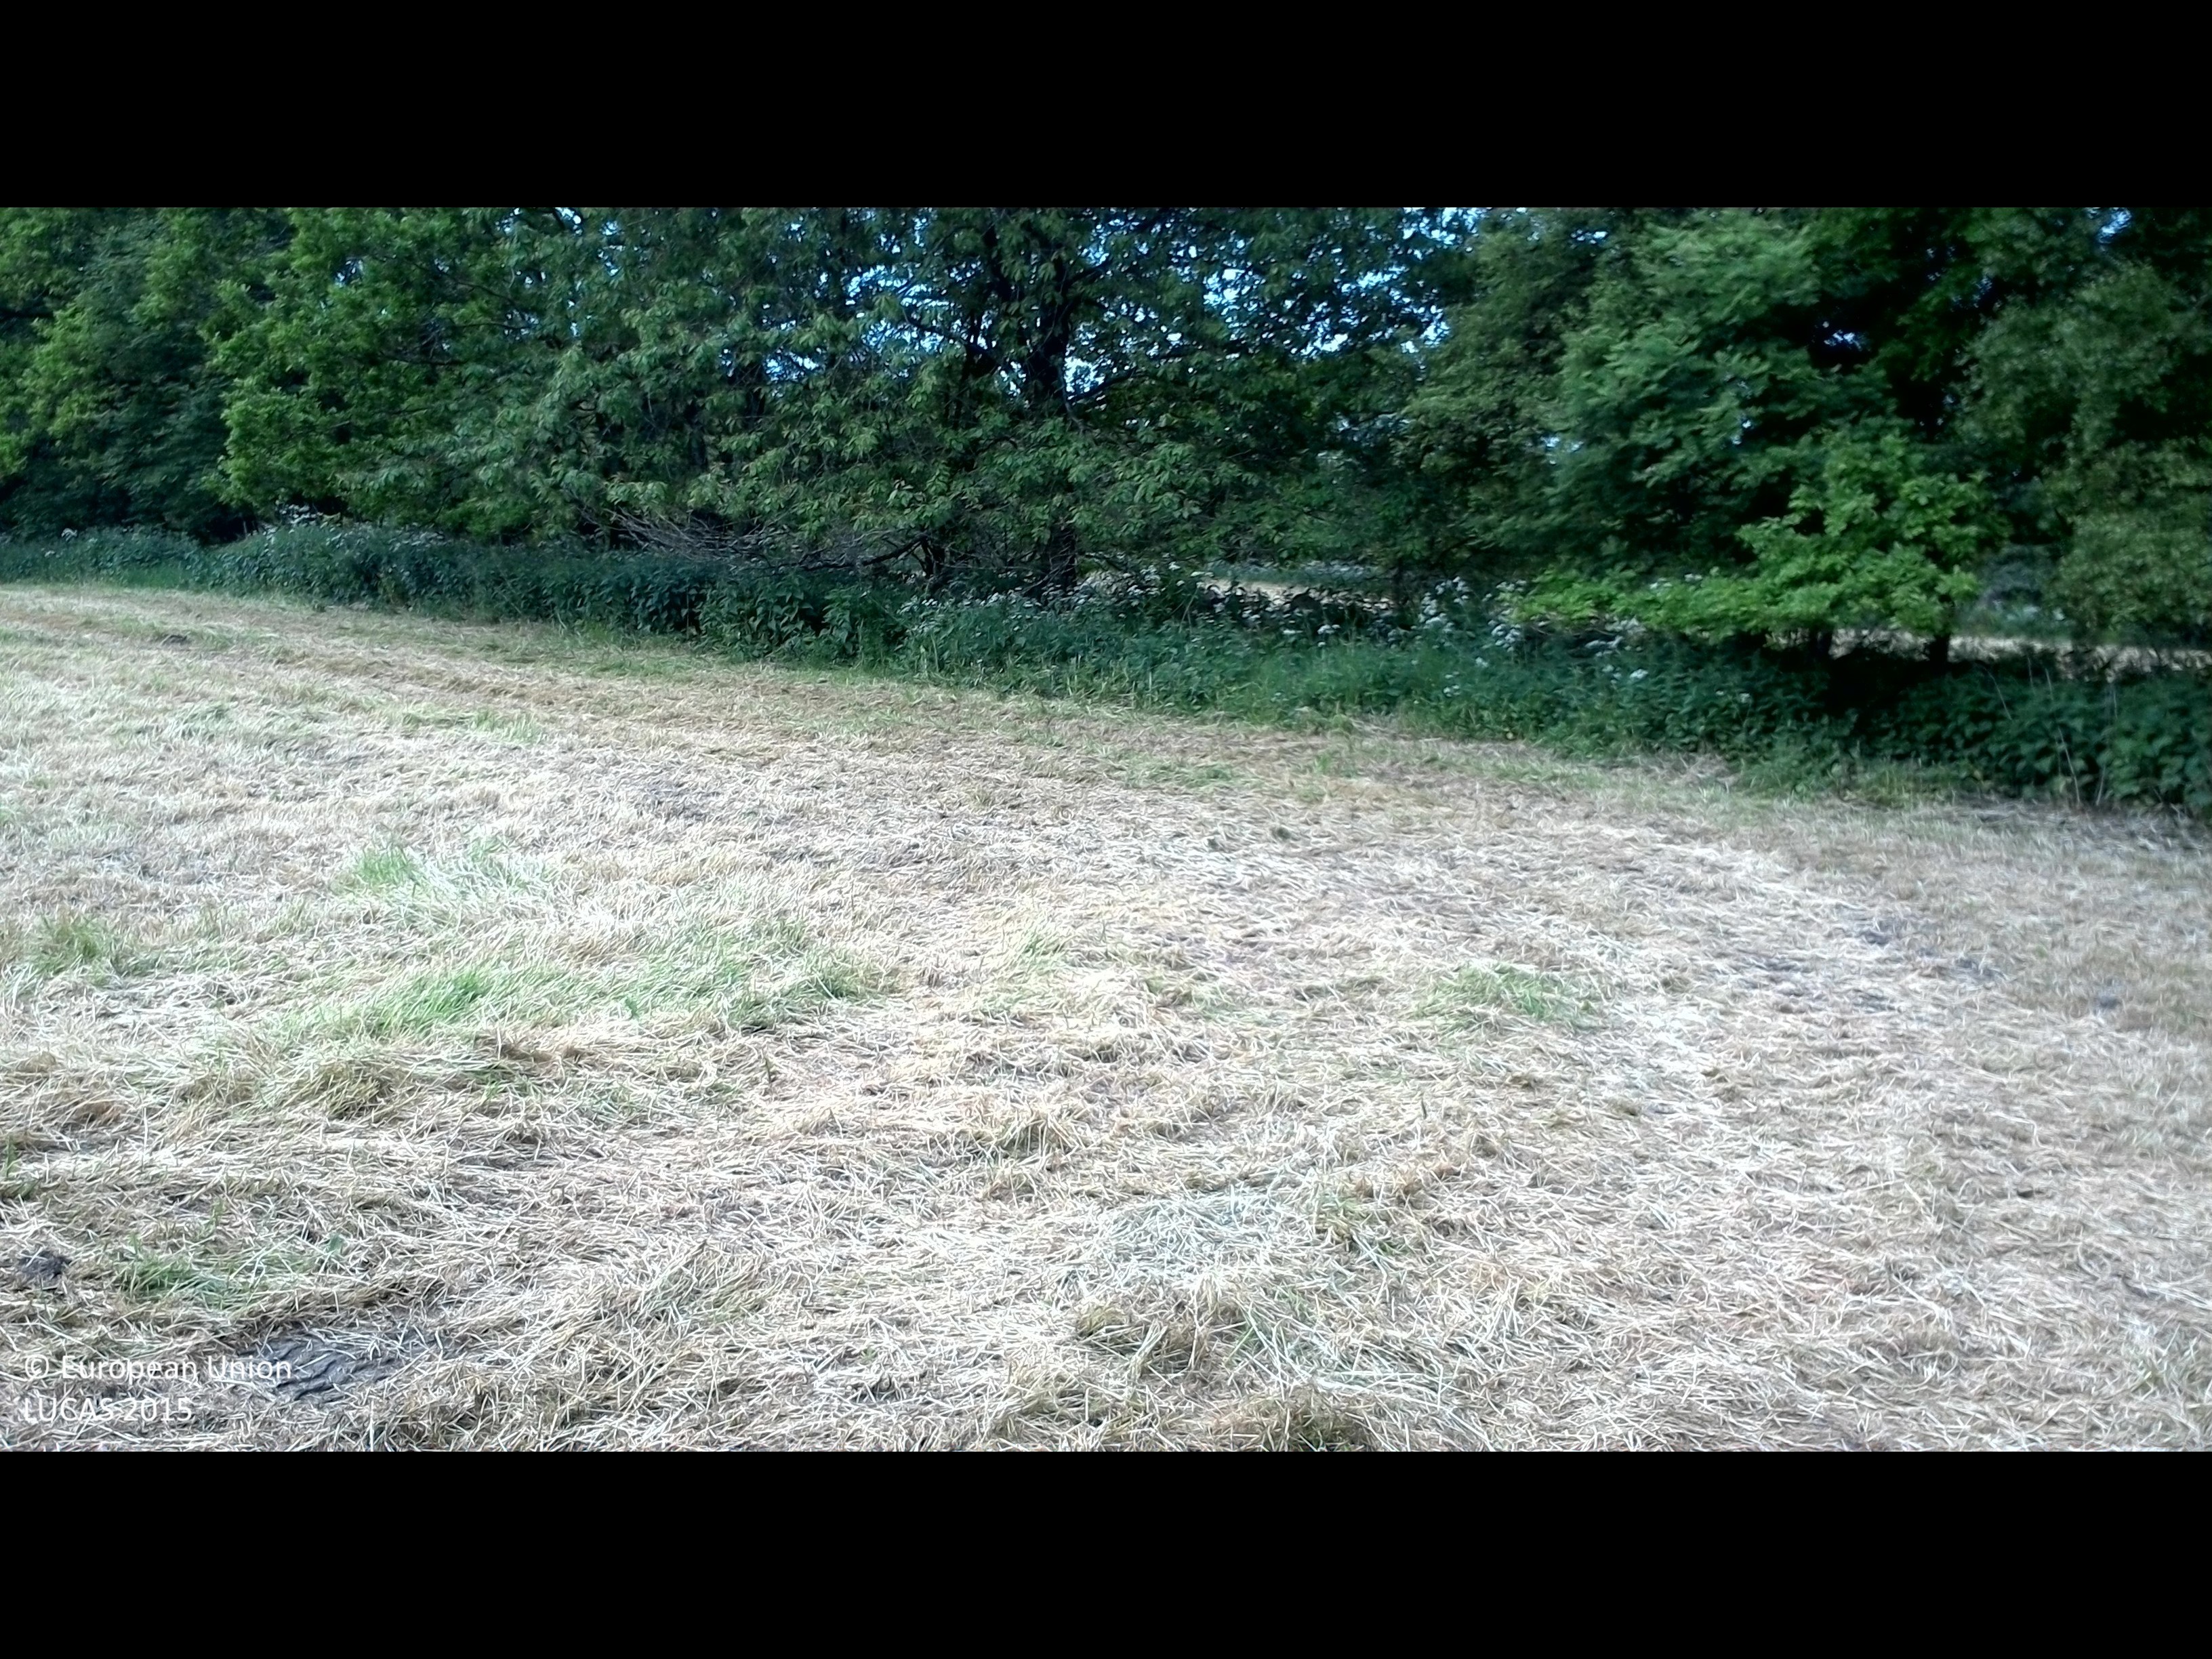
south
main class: Grassland
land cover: Grassland without tree/shrub cover
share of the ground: > 75 %
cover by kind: herbaceous plants 100 %
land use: Agriculture (excluding fallow land and kitchen gardens)
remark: Harvested field
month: June
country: SE
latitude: 55.8552
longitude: 14.0078
